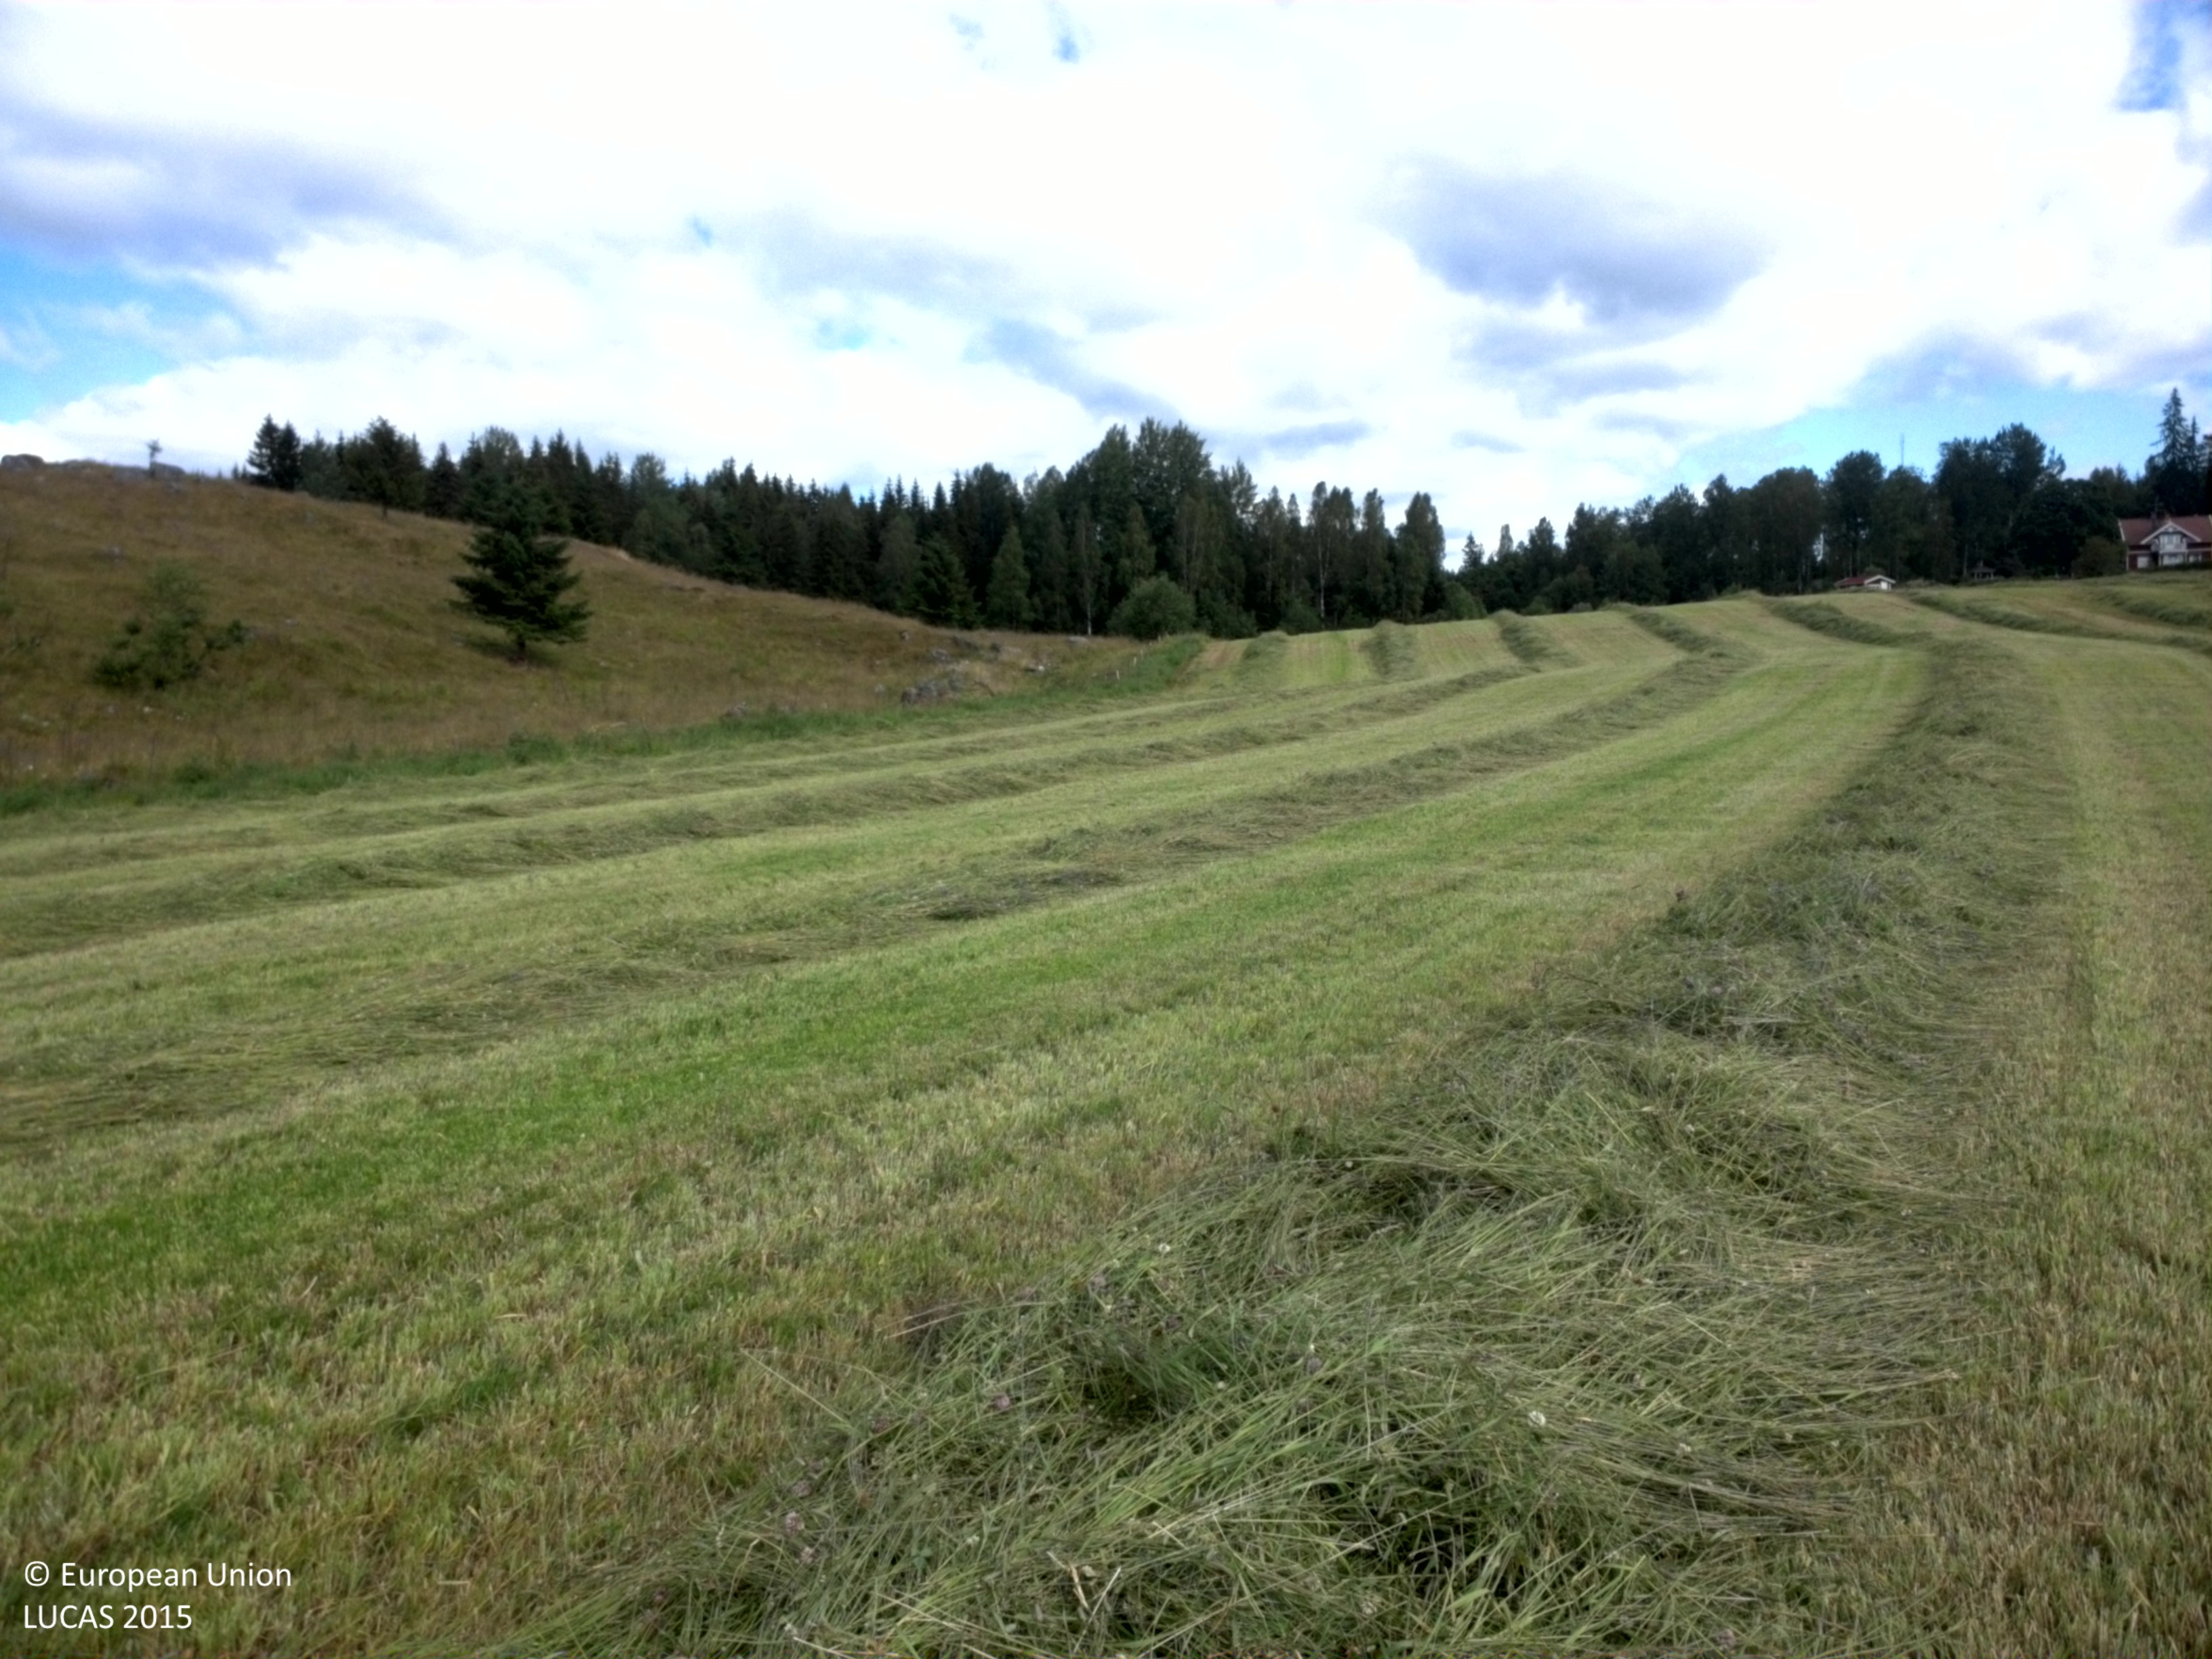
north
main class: Cropland
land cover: Other leguminous and mixtures for fodder
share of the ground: > 75 %
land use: Agriculture (excluding fallow land and kitchen gardens)
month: July
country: SE
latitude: 59.8534
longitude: 12.4389
